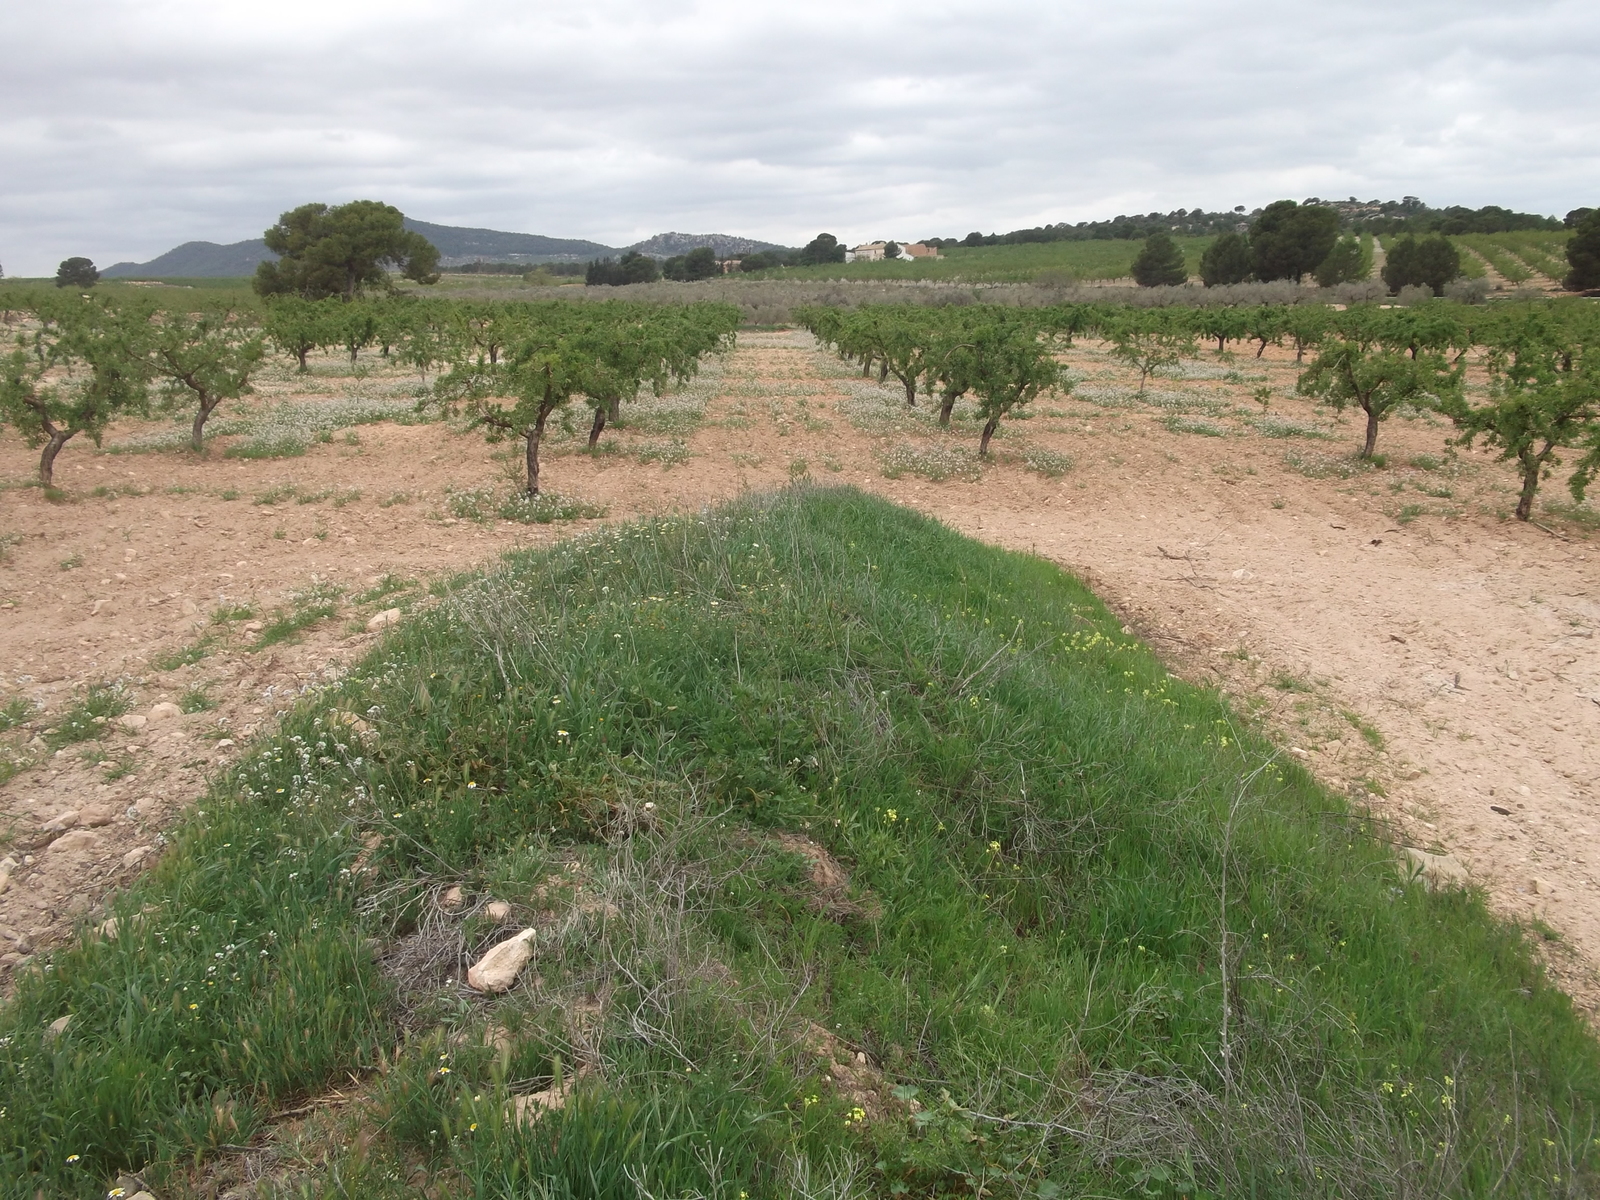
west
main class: Shrubland
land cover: Shrubland without tree cover
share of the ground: 25 - 50 %
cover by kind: shrubs 50 %, herbaceous plants 50 %
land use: Abandoned areas
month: April
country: ES
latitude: 38.0983
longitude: -1.5846
